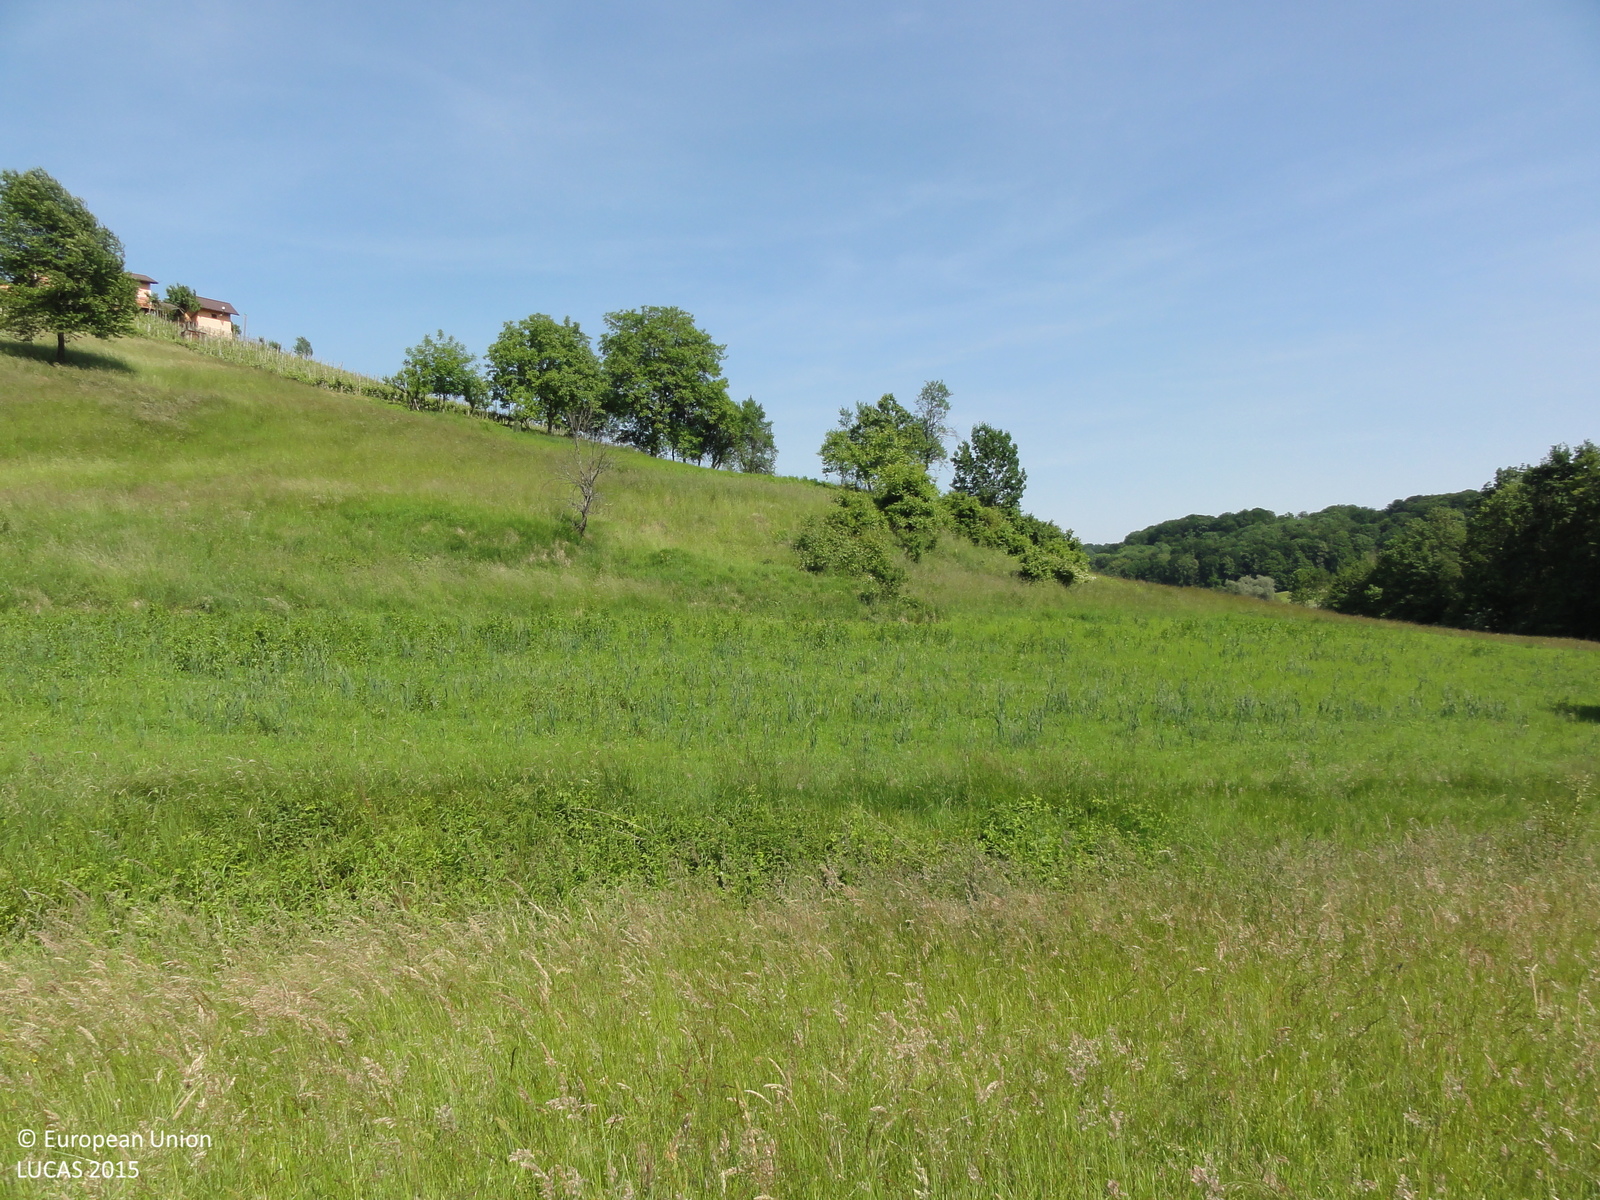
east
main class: Grassland
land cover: Grassland without tree/shrub cover
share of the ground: > 75 %
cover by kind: herbaceous plants 100 %
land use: Agriculture (excluding fallow land and kitchen gardens)
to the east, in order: Grassland without tree/shrub cover; Rivers and streams; Spontaneously vegetated surfaces; Grassland with sparse tree/shrub cover; Grassland without tree/shrub cover; Spontaneously vegetated surfaces; Grassland without tree/shrub cover; Pear fruit; Grass margins; Vineyards; Grass margins; Tracks; Vineyards; Tracks; Spontaneously vegetated surfaces; Grassland without tree/shrub cover
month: May
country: SI
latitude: 46.6128
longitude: 15.7316
